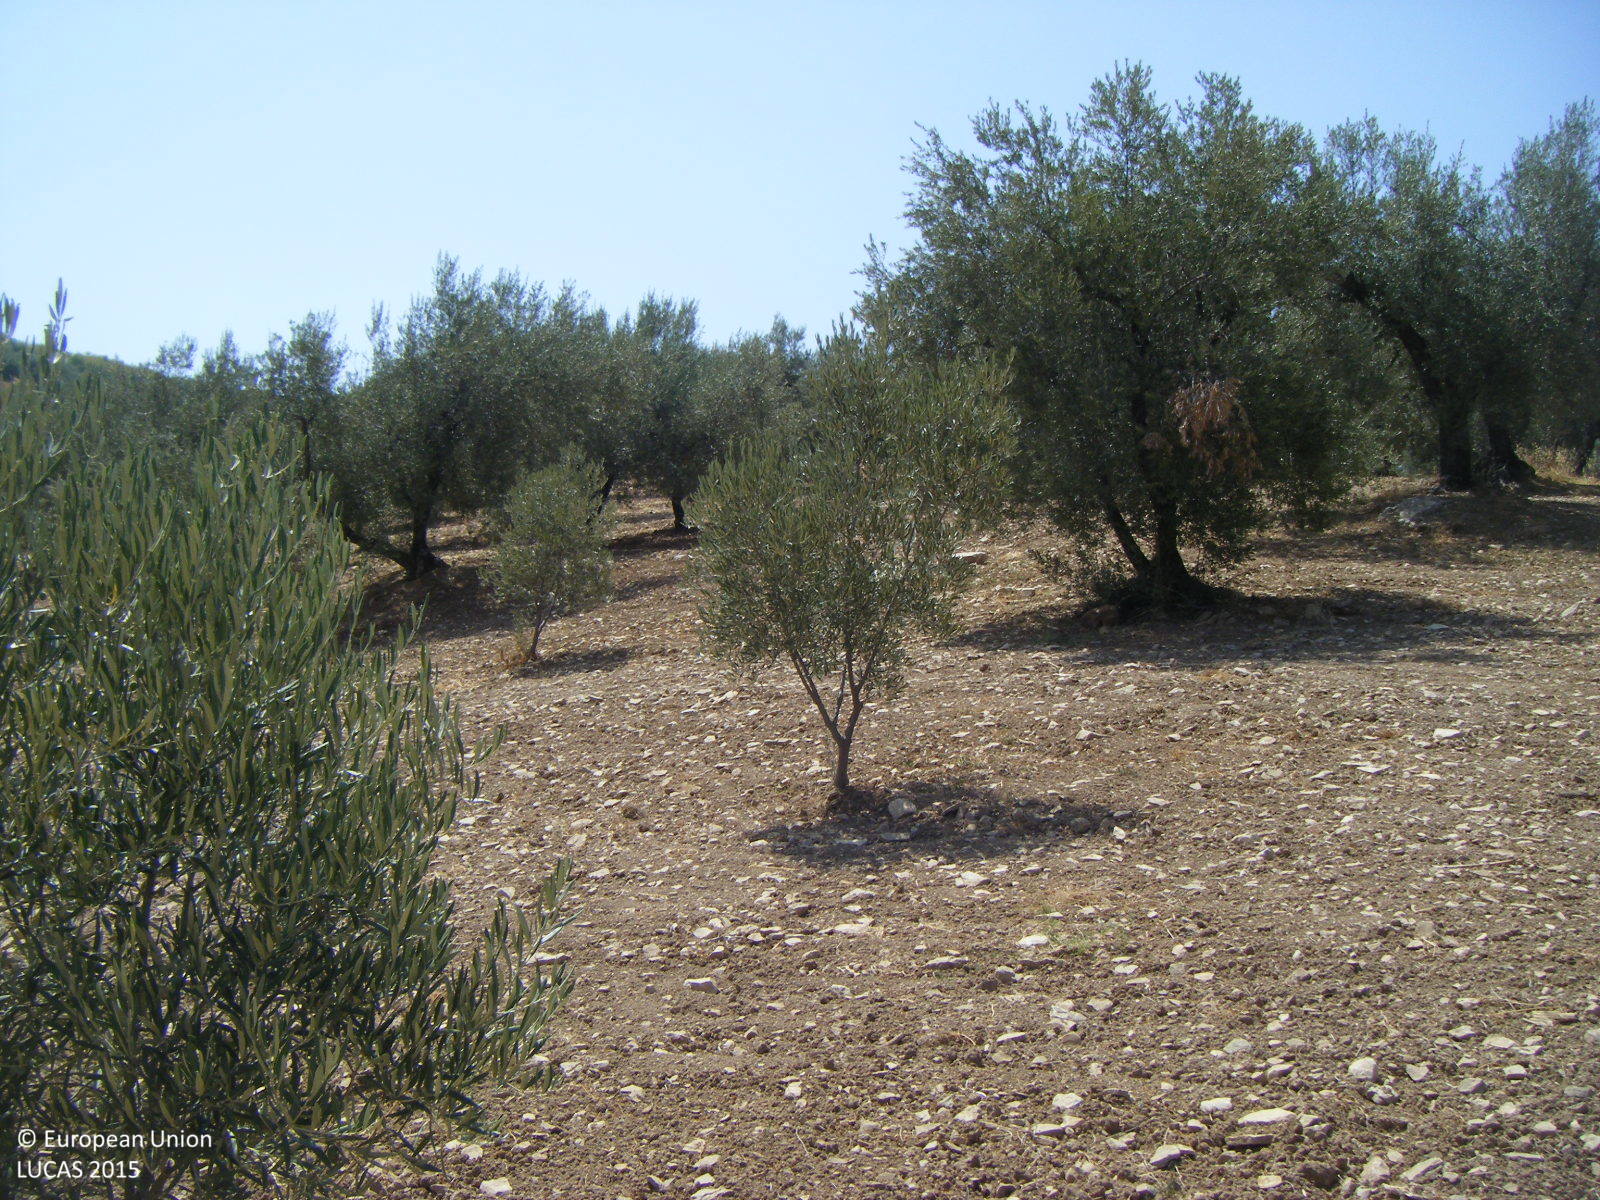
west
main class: Cropland
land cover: Olive groves
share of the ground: 10 - 25 %
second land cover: Other bare soil
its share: > 75 %
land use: Agriculture (excluding fallow land and kitchen gardens)
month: July
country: ES
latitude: 36.8887
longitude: -4.2524
